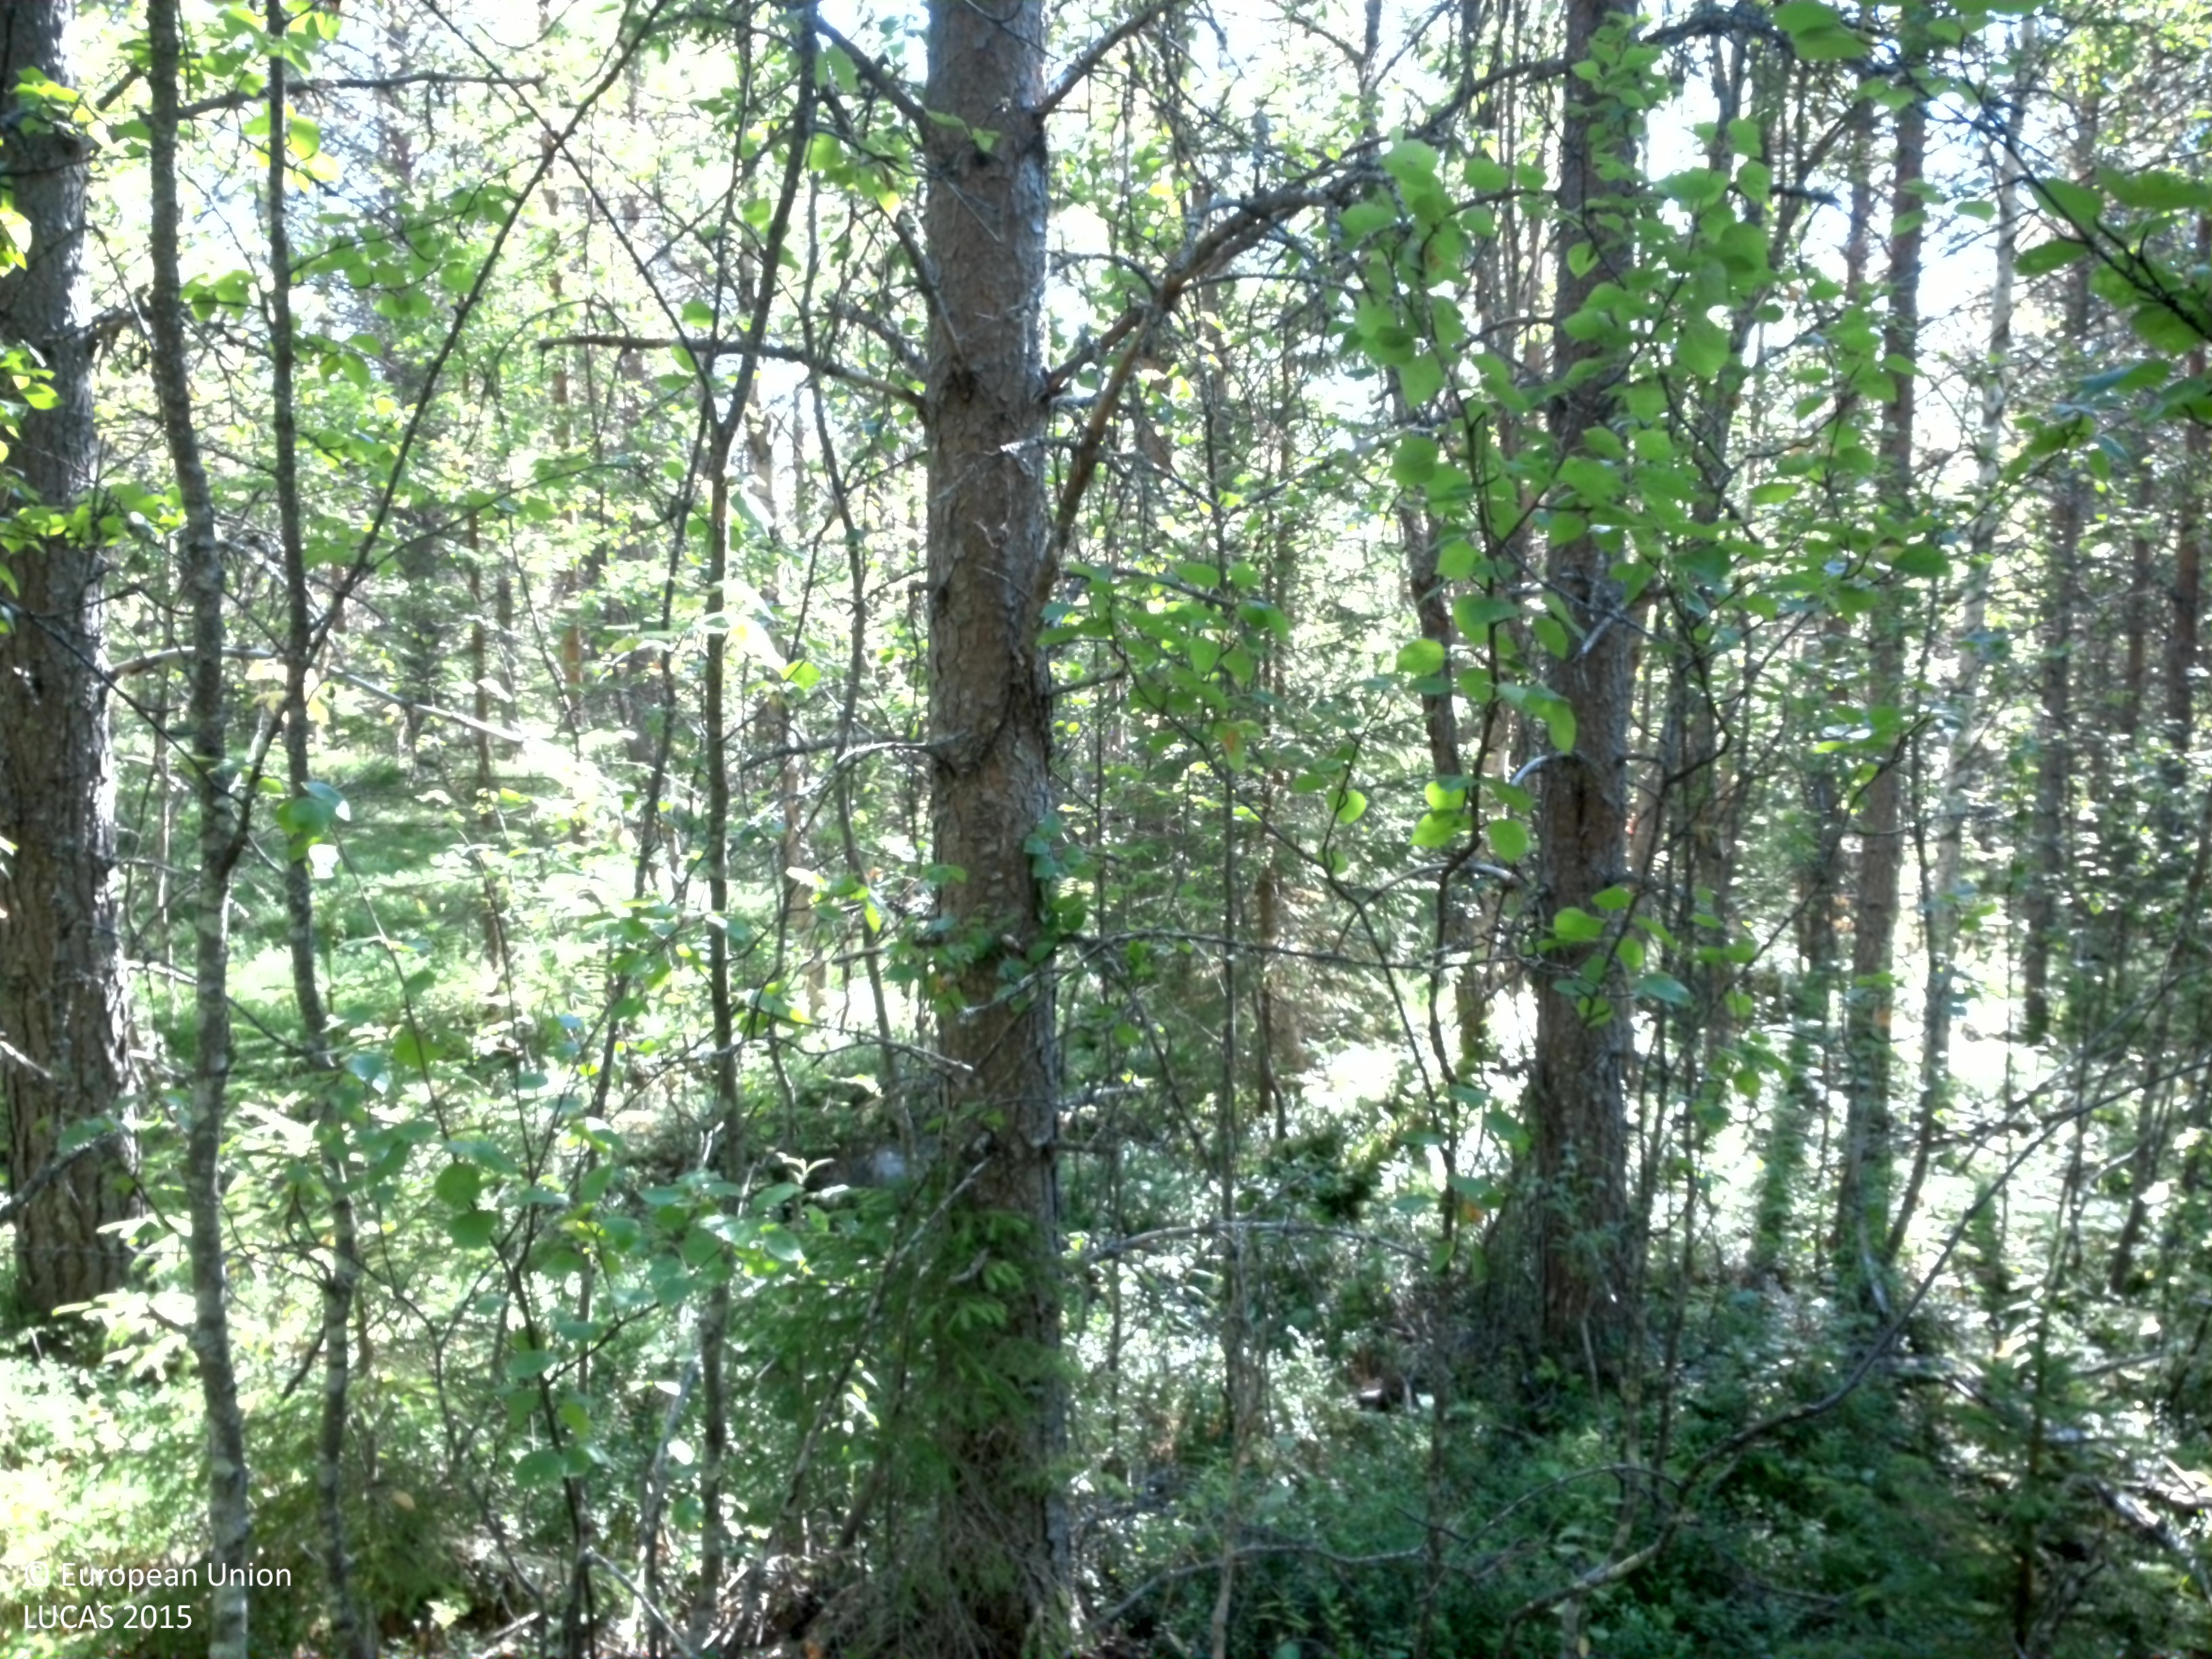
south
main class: Woodland
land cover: Pine dominated mixed woodland
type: boreal forest
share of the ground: 50 - 75 %
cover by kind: coniferous forest trees 35 %, broadleaved forest trees 30 %, shrubs 25 %, herbaceous plants 10 %
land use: Forestry
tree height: > 5 m
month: August
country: SE
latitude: 64.6740
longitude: 16.6920
